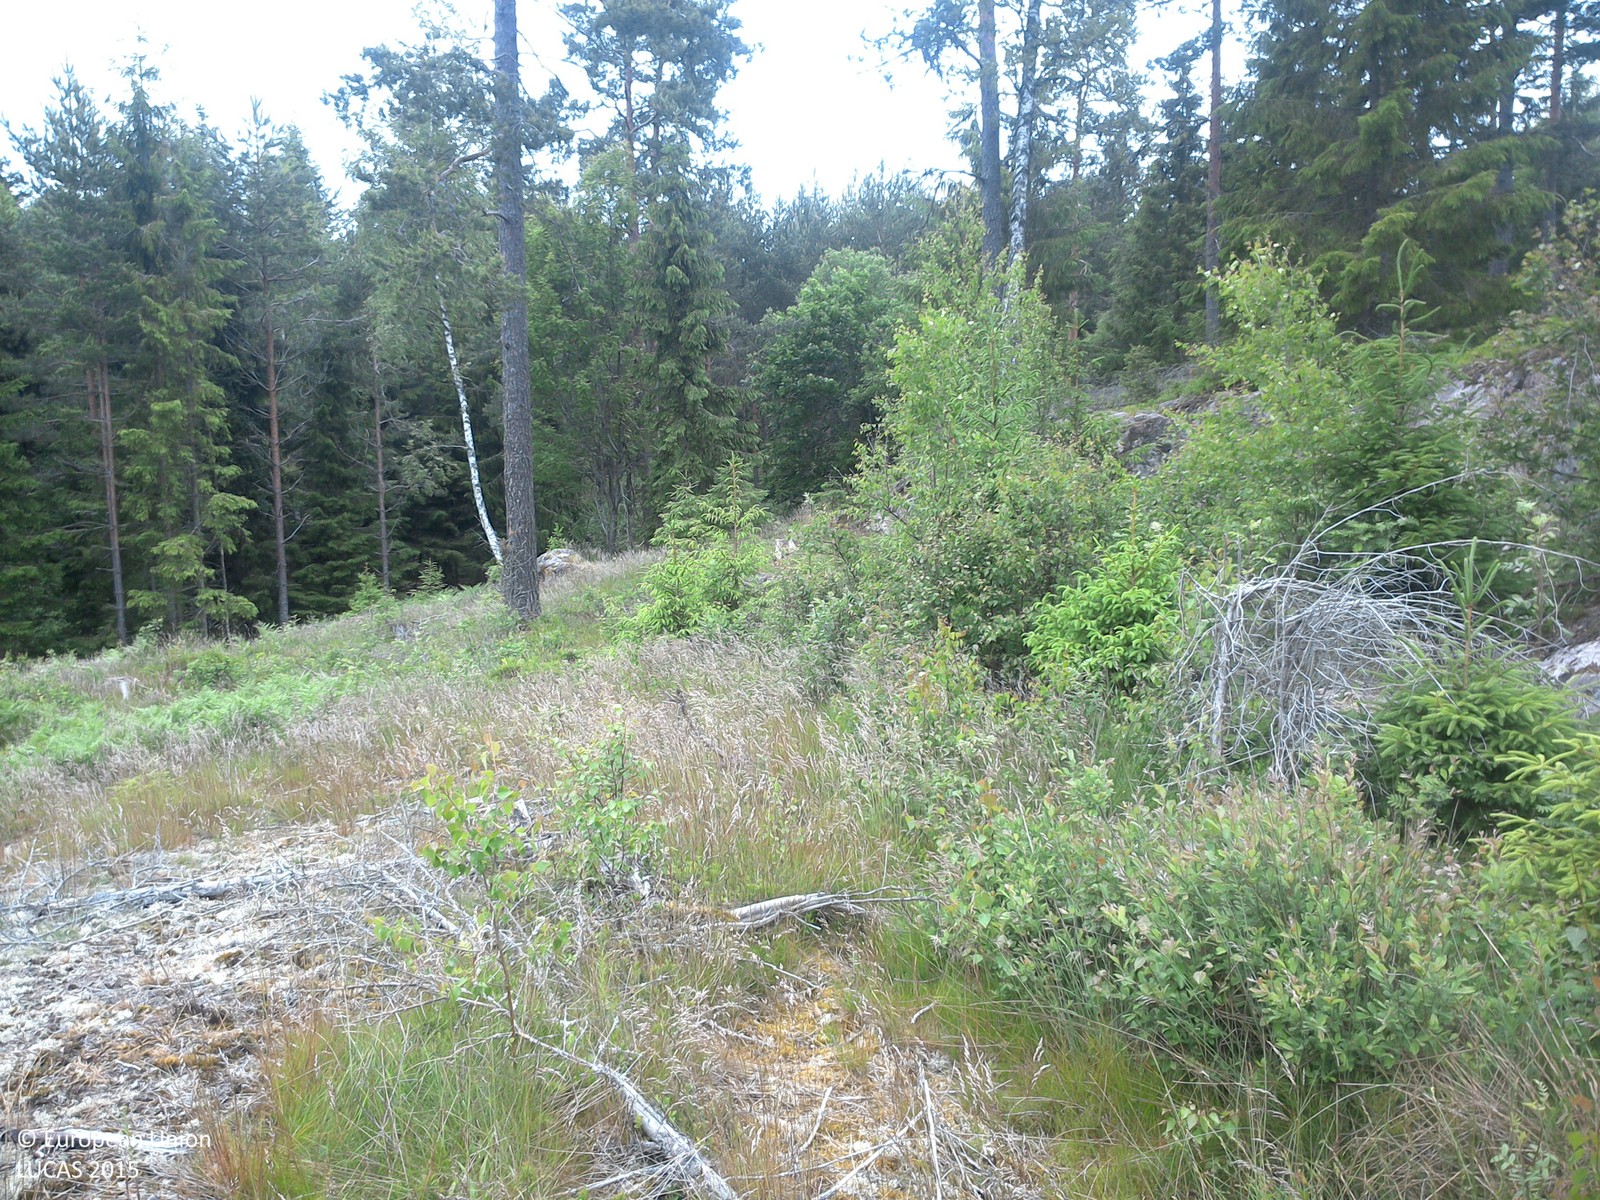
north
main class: Woodland
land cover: Pine dominated coniferous woodland
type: boreal forest
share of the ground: 10 - 25 %
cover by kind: herbaceous plants 45 %, lichens and mosses 40 %, coniferous forest trees 15 %
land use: Forestry
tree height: > 5 m
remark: Clear cut
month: June
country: SE
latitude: 58.1452
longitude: 15.4482
